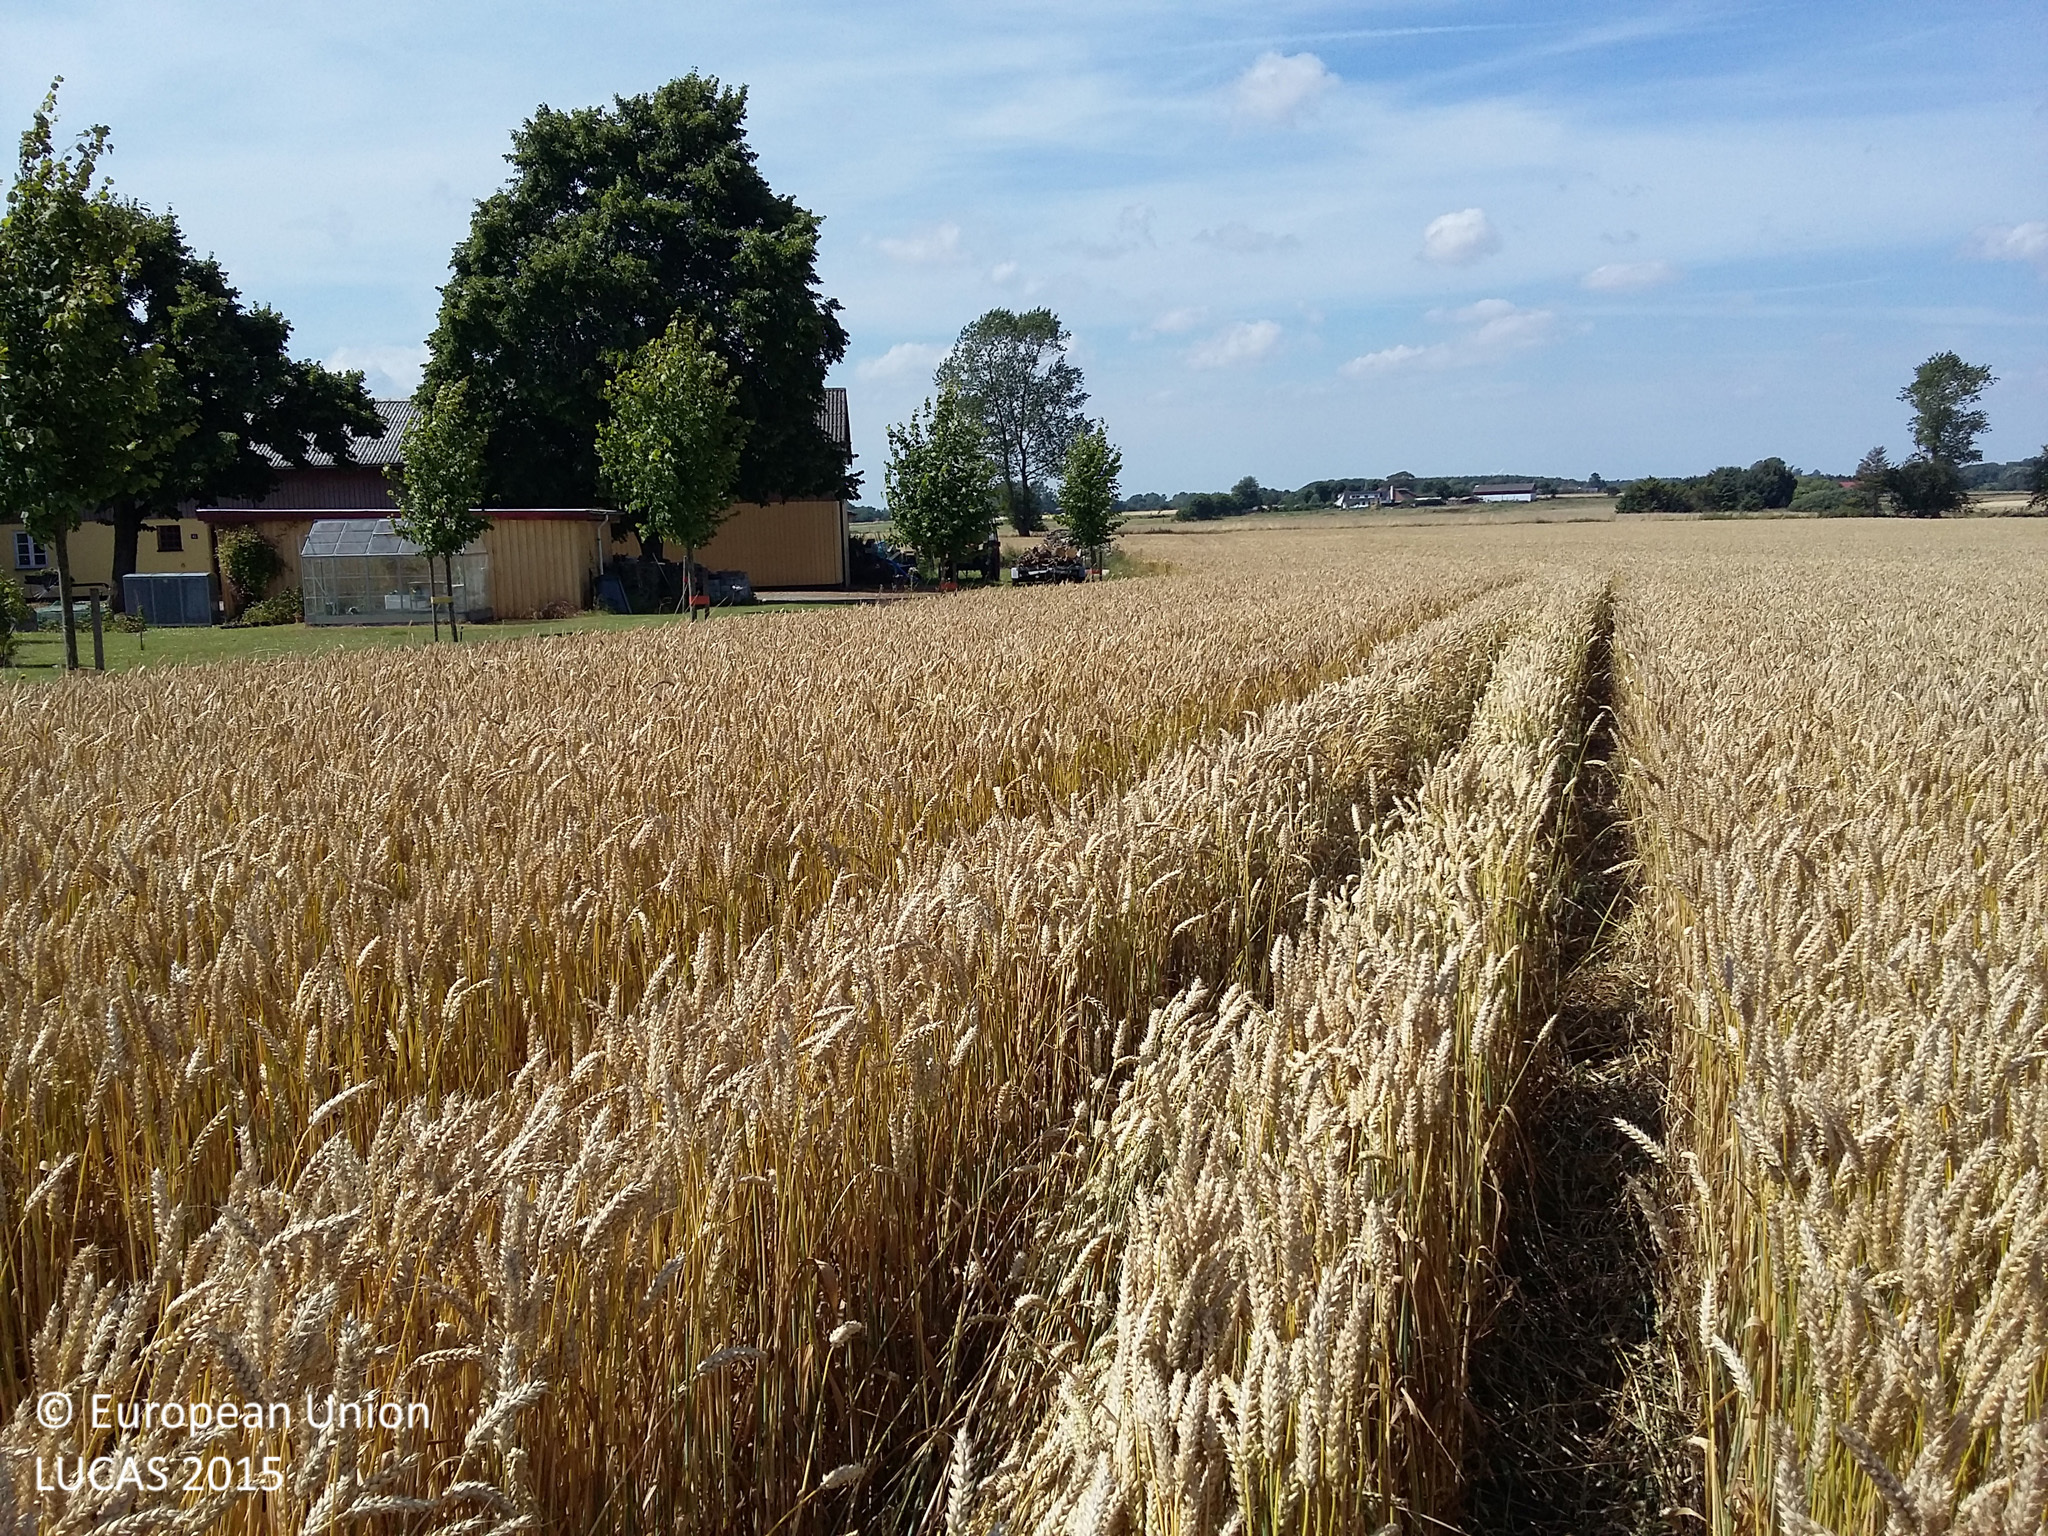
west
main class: Cropland
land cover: Common wheat
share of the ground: > 75 %
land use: Agriculture (excluding fallow land and kitchen gardens)
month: August
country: DK
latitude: 55.3825
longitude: 11.9083
